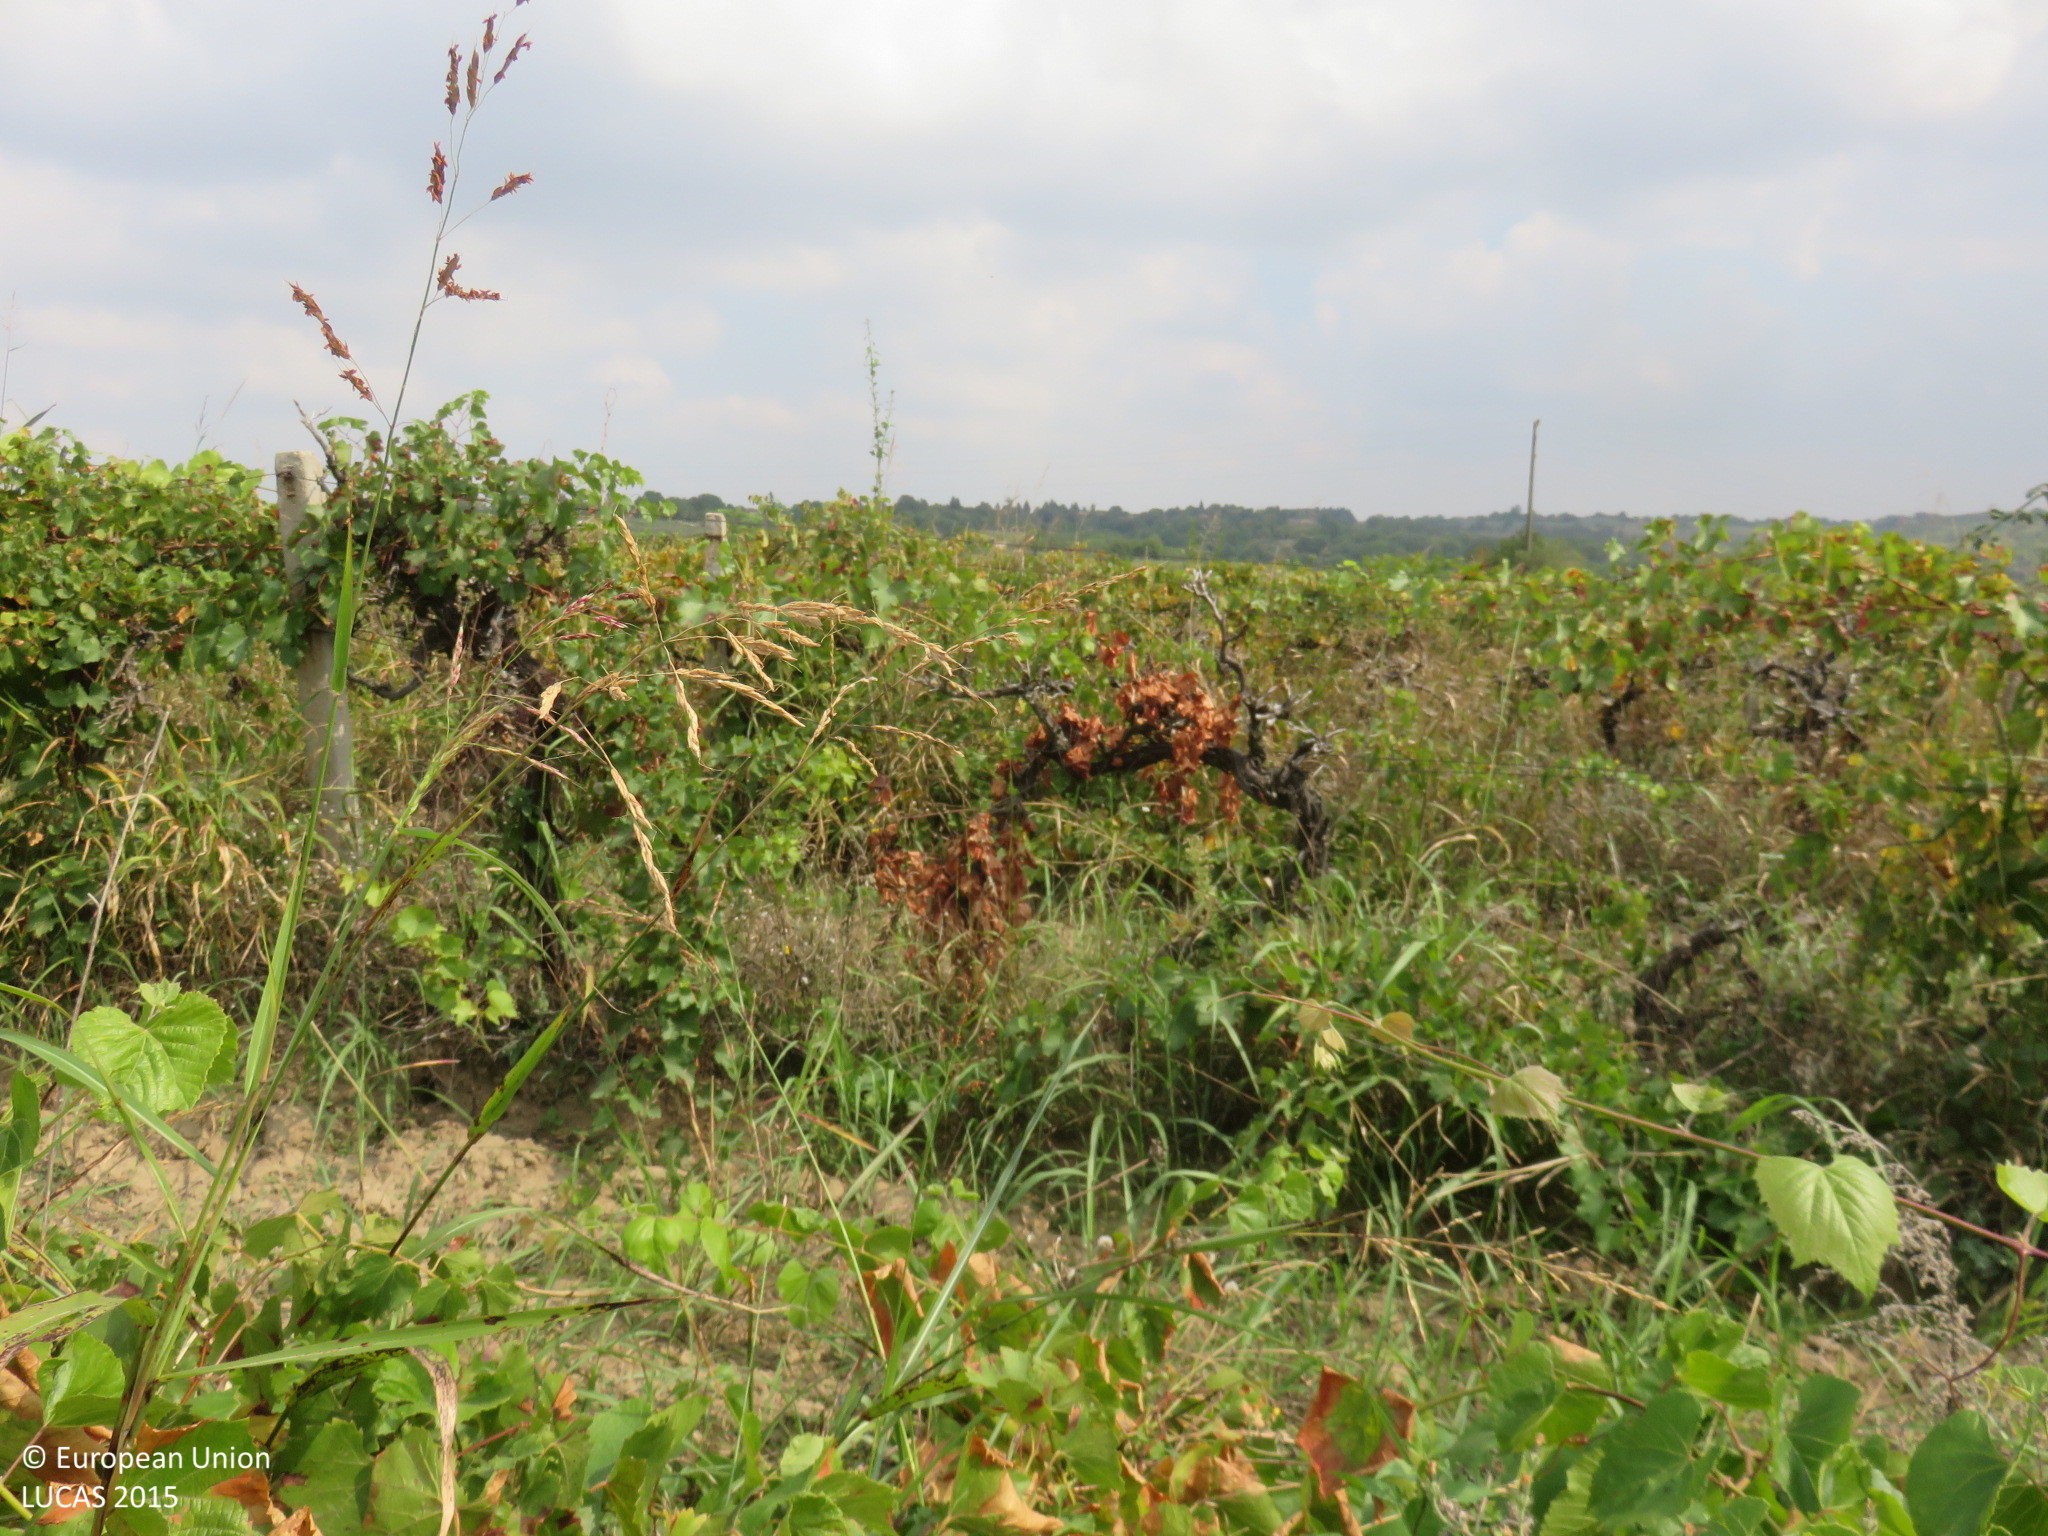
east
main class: Cropland
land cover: Vineyards
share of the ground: > 75 %
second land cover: Spontaneously vegetated surfaces
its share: 25 - 50 %
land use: Agriculture (excluding fallow land and kitchen gardens)
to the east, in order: Vineyards; Spontaneously vegetated surfaces; Electric lines; Vineyards; Tracks; Grassland with sparse tree/shrub cover; Grassland without tree/shrub cover; Grassland with sparse tree/shrub cover; Broadleaved woodland
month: September
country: BG
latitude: 43.6118
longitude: 24.9270
